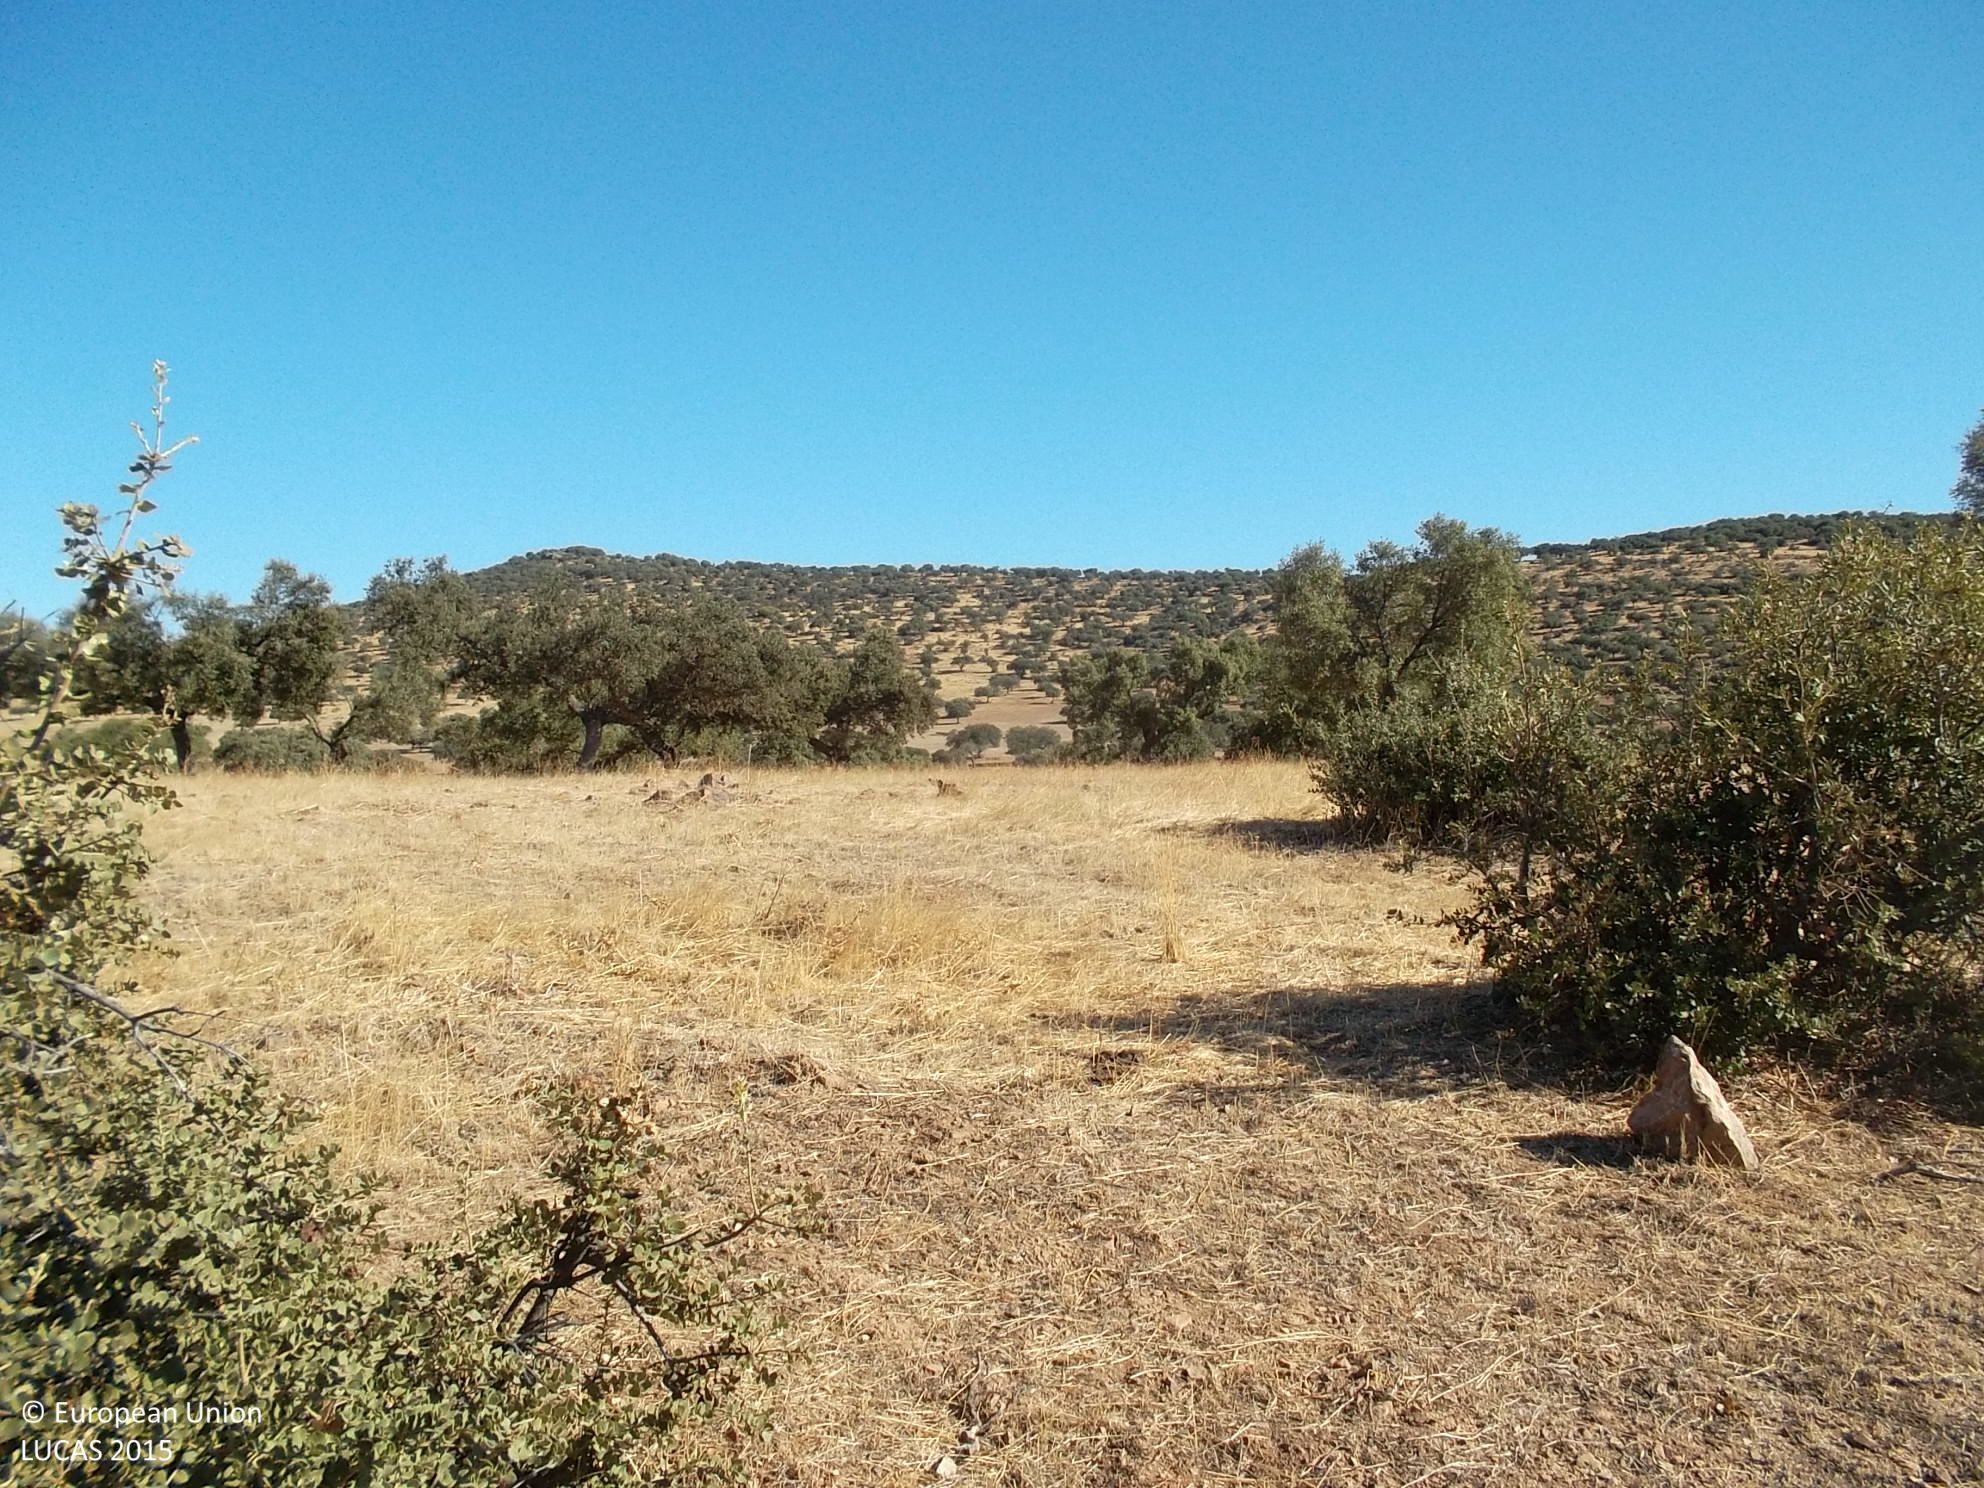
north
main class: Woodland
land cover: Broadleaved woodland
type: broadleaved evergreen forest
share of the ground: 10 - 25 %
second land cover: Grassland without tree/shrub cover
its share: > 75 %
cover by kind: herbaceous plants 85 %, broadleaved forest trees 10 %, shrubs 5 %
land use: Forestry
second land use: Agriculture (excluding fallow land and kitchen gardens)
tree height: < 5 m
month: August
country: ES
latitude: 38.5272
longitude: -6.6082
